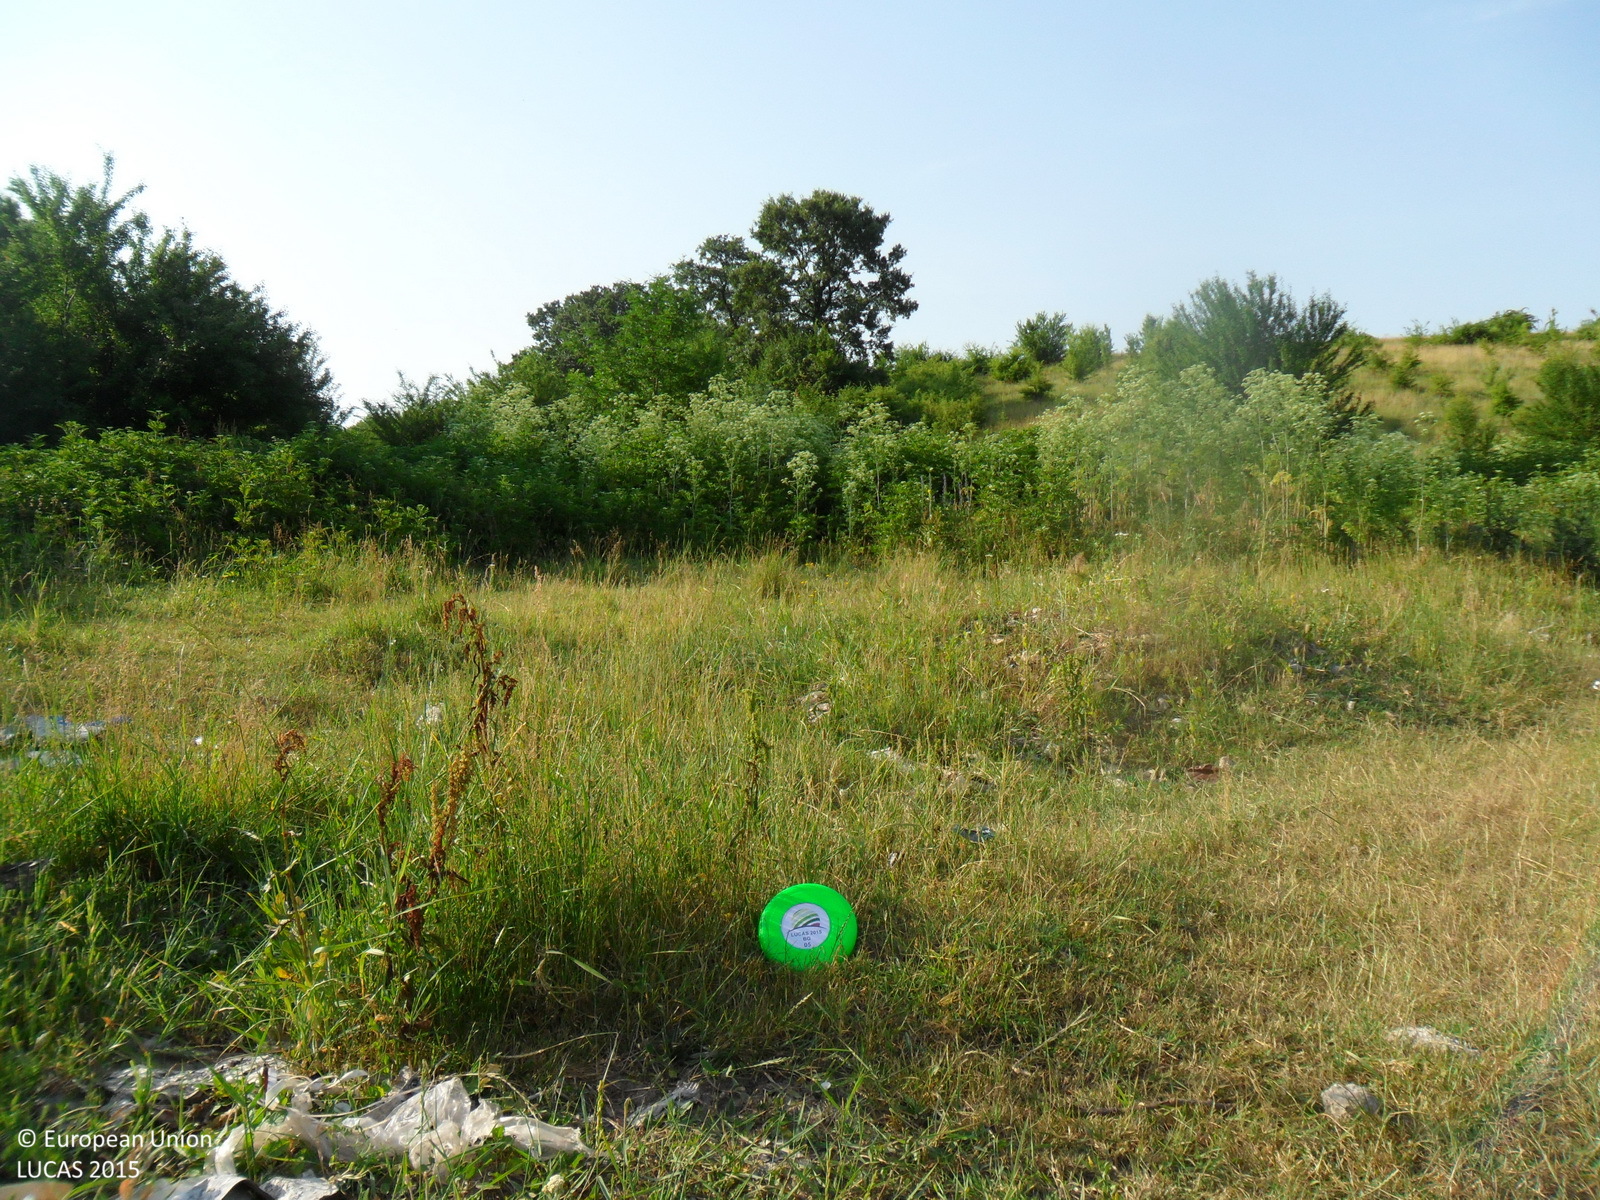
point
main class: Grassland
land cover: Grassland with sparse tree/shrub cover
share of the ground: > 75 %
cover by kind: herbaceous plants 90 %, broadleaved forest trees 5 %, shrubs 5 %
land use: Agriculture (excluding fallow land and kitchen gardens)
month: June
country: BG
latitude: 43.6957
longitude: 26.8538
